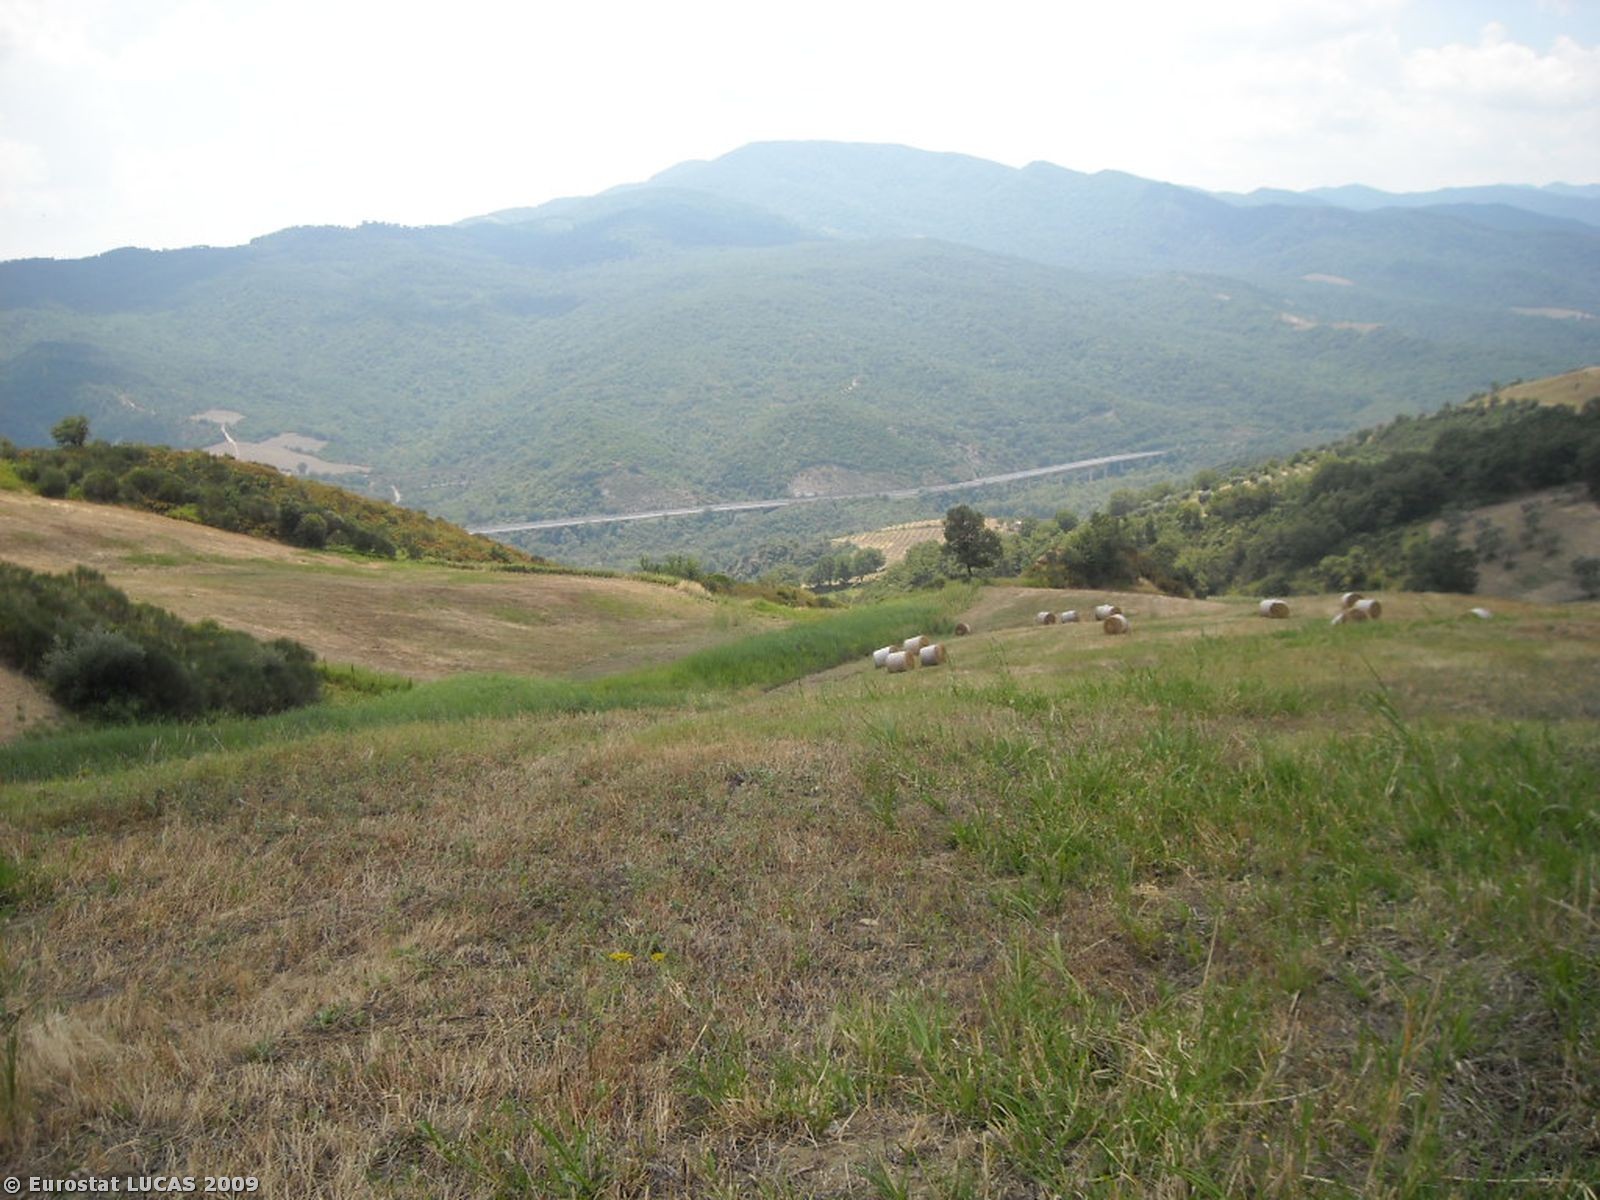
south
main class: Cropland
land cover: Mixed cereals for fodder
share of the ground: < 10 %
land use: Agriculture (excluding fallow land and kitchen gardens)
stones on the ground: < 10 %
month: July
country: IT
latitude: 40.6014
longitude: 16.1339
